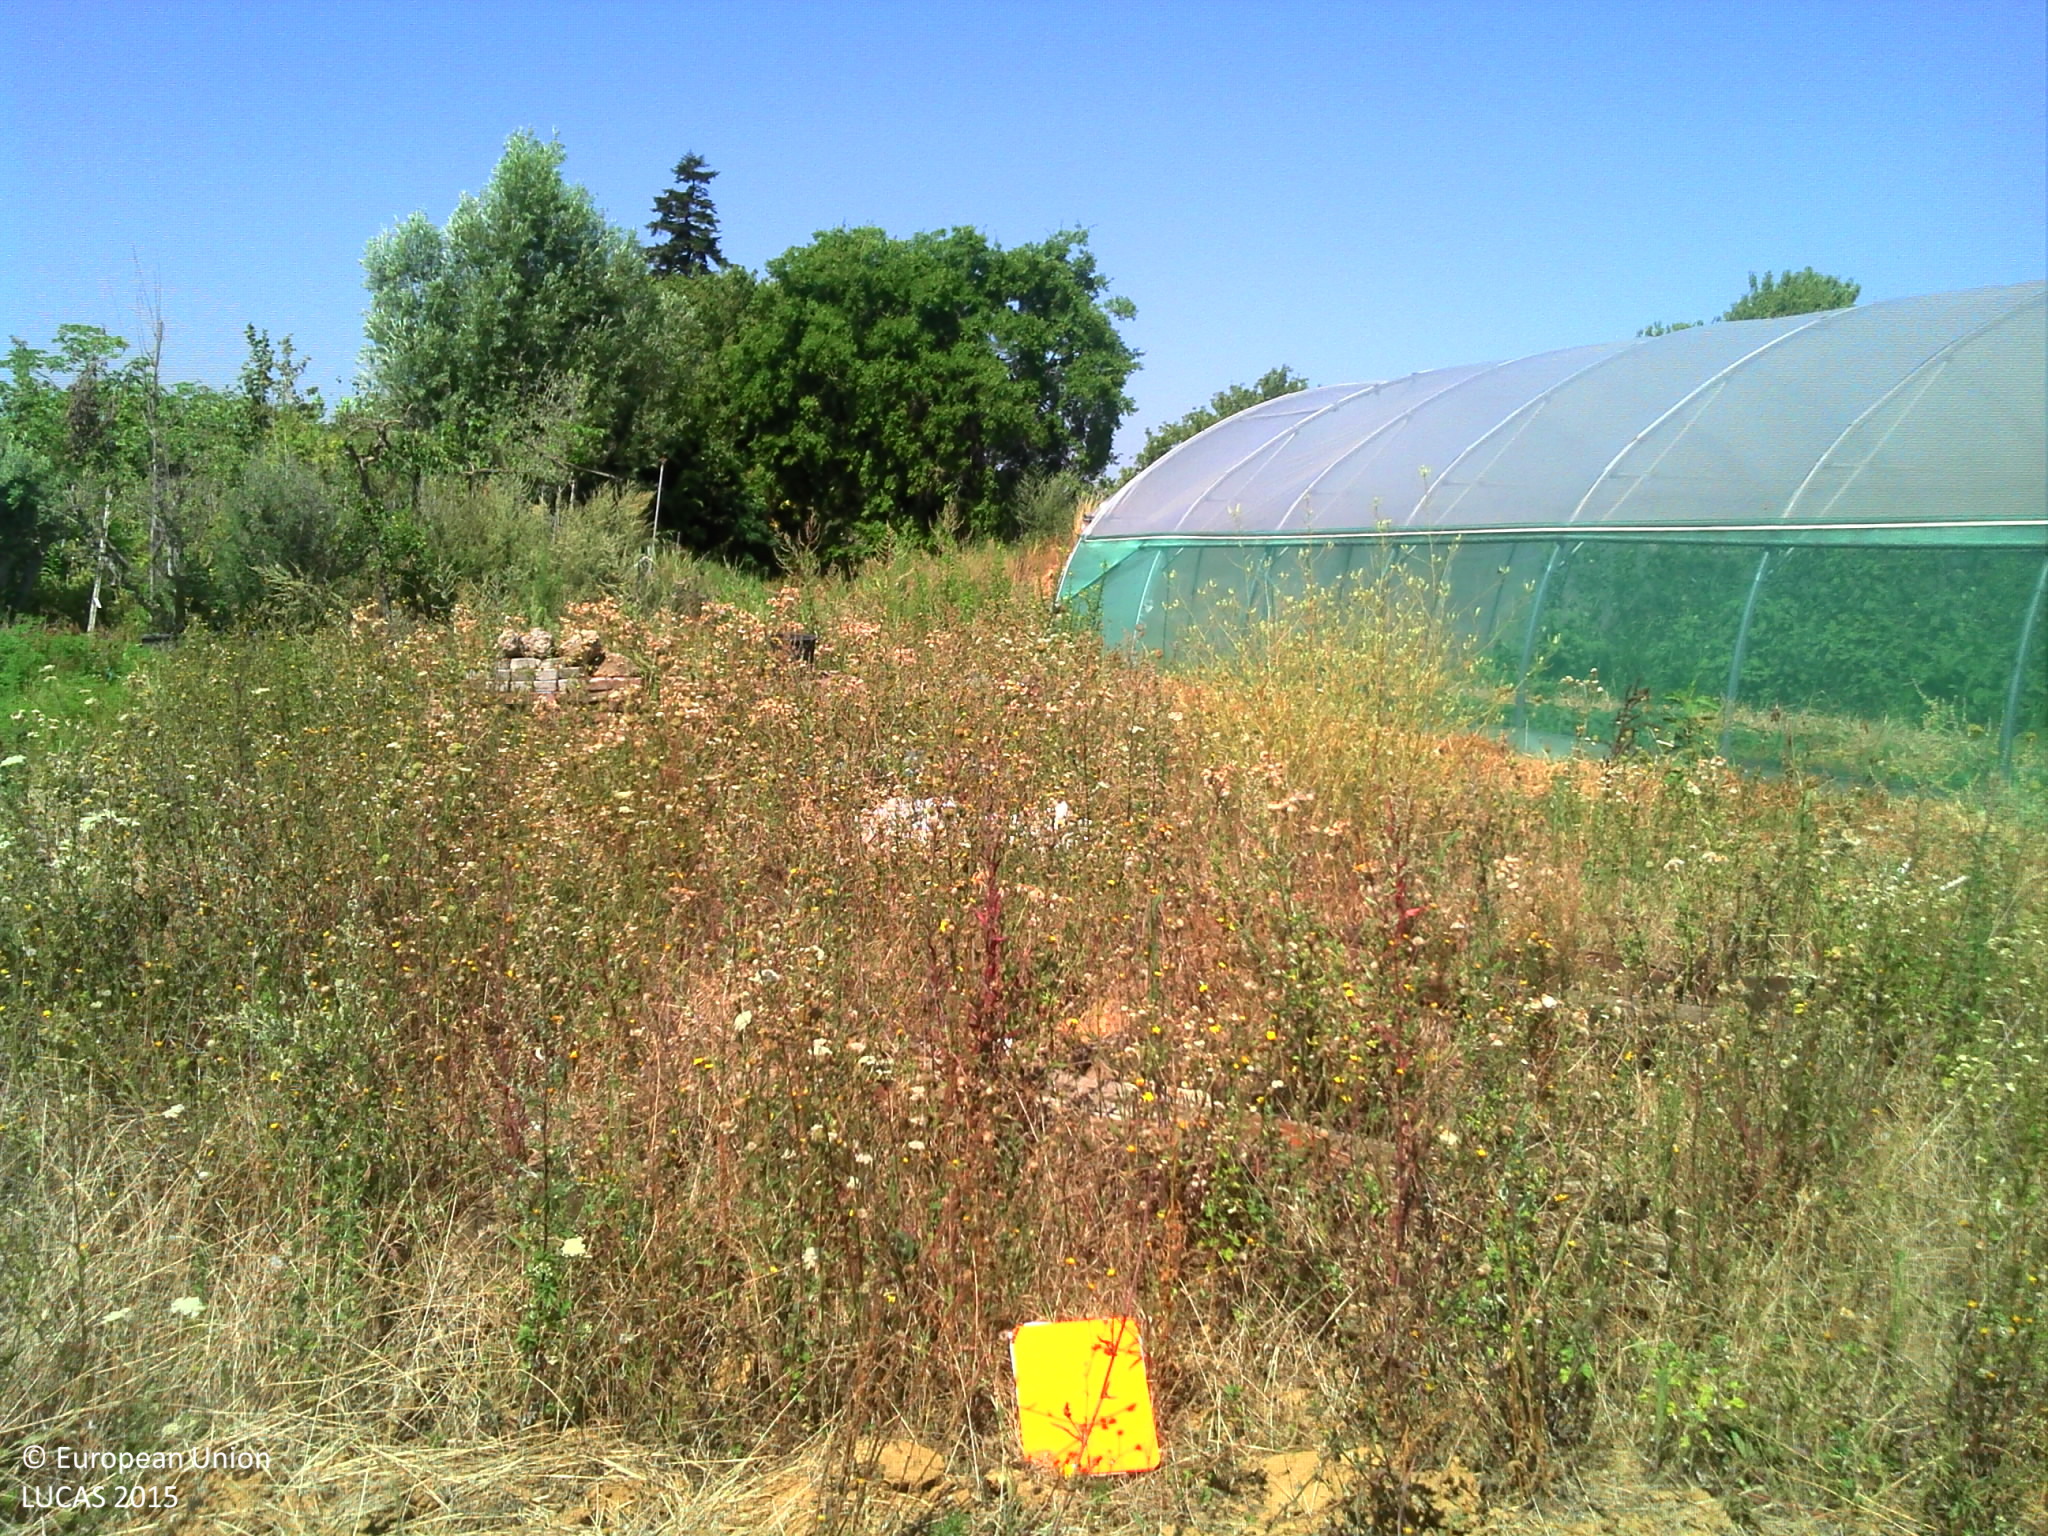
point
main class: Grassland
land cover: Spontaneously vegetated surfaces
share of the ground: > 75 %
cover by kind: herbaceous plants 95 %, shrubs 5 %
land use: Agriculture (excluding fallow land and kitchen gardens)
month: August
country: FR
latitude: 45.6500
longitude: 4.8583
